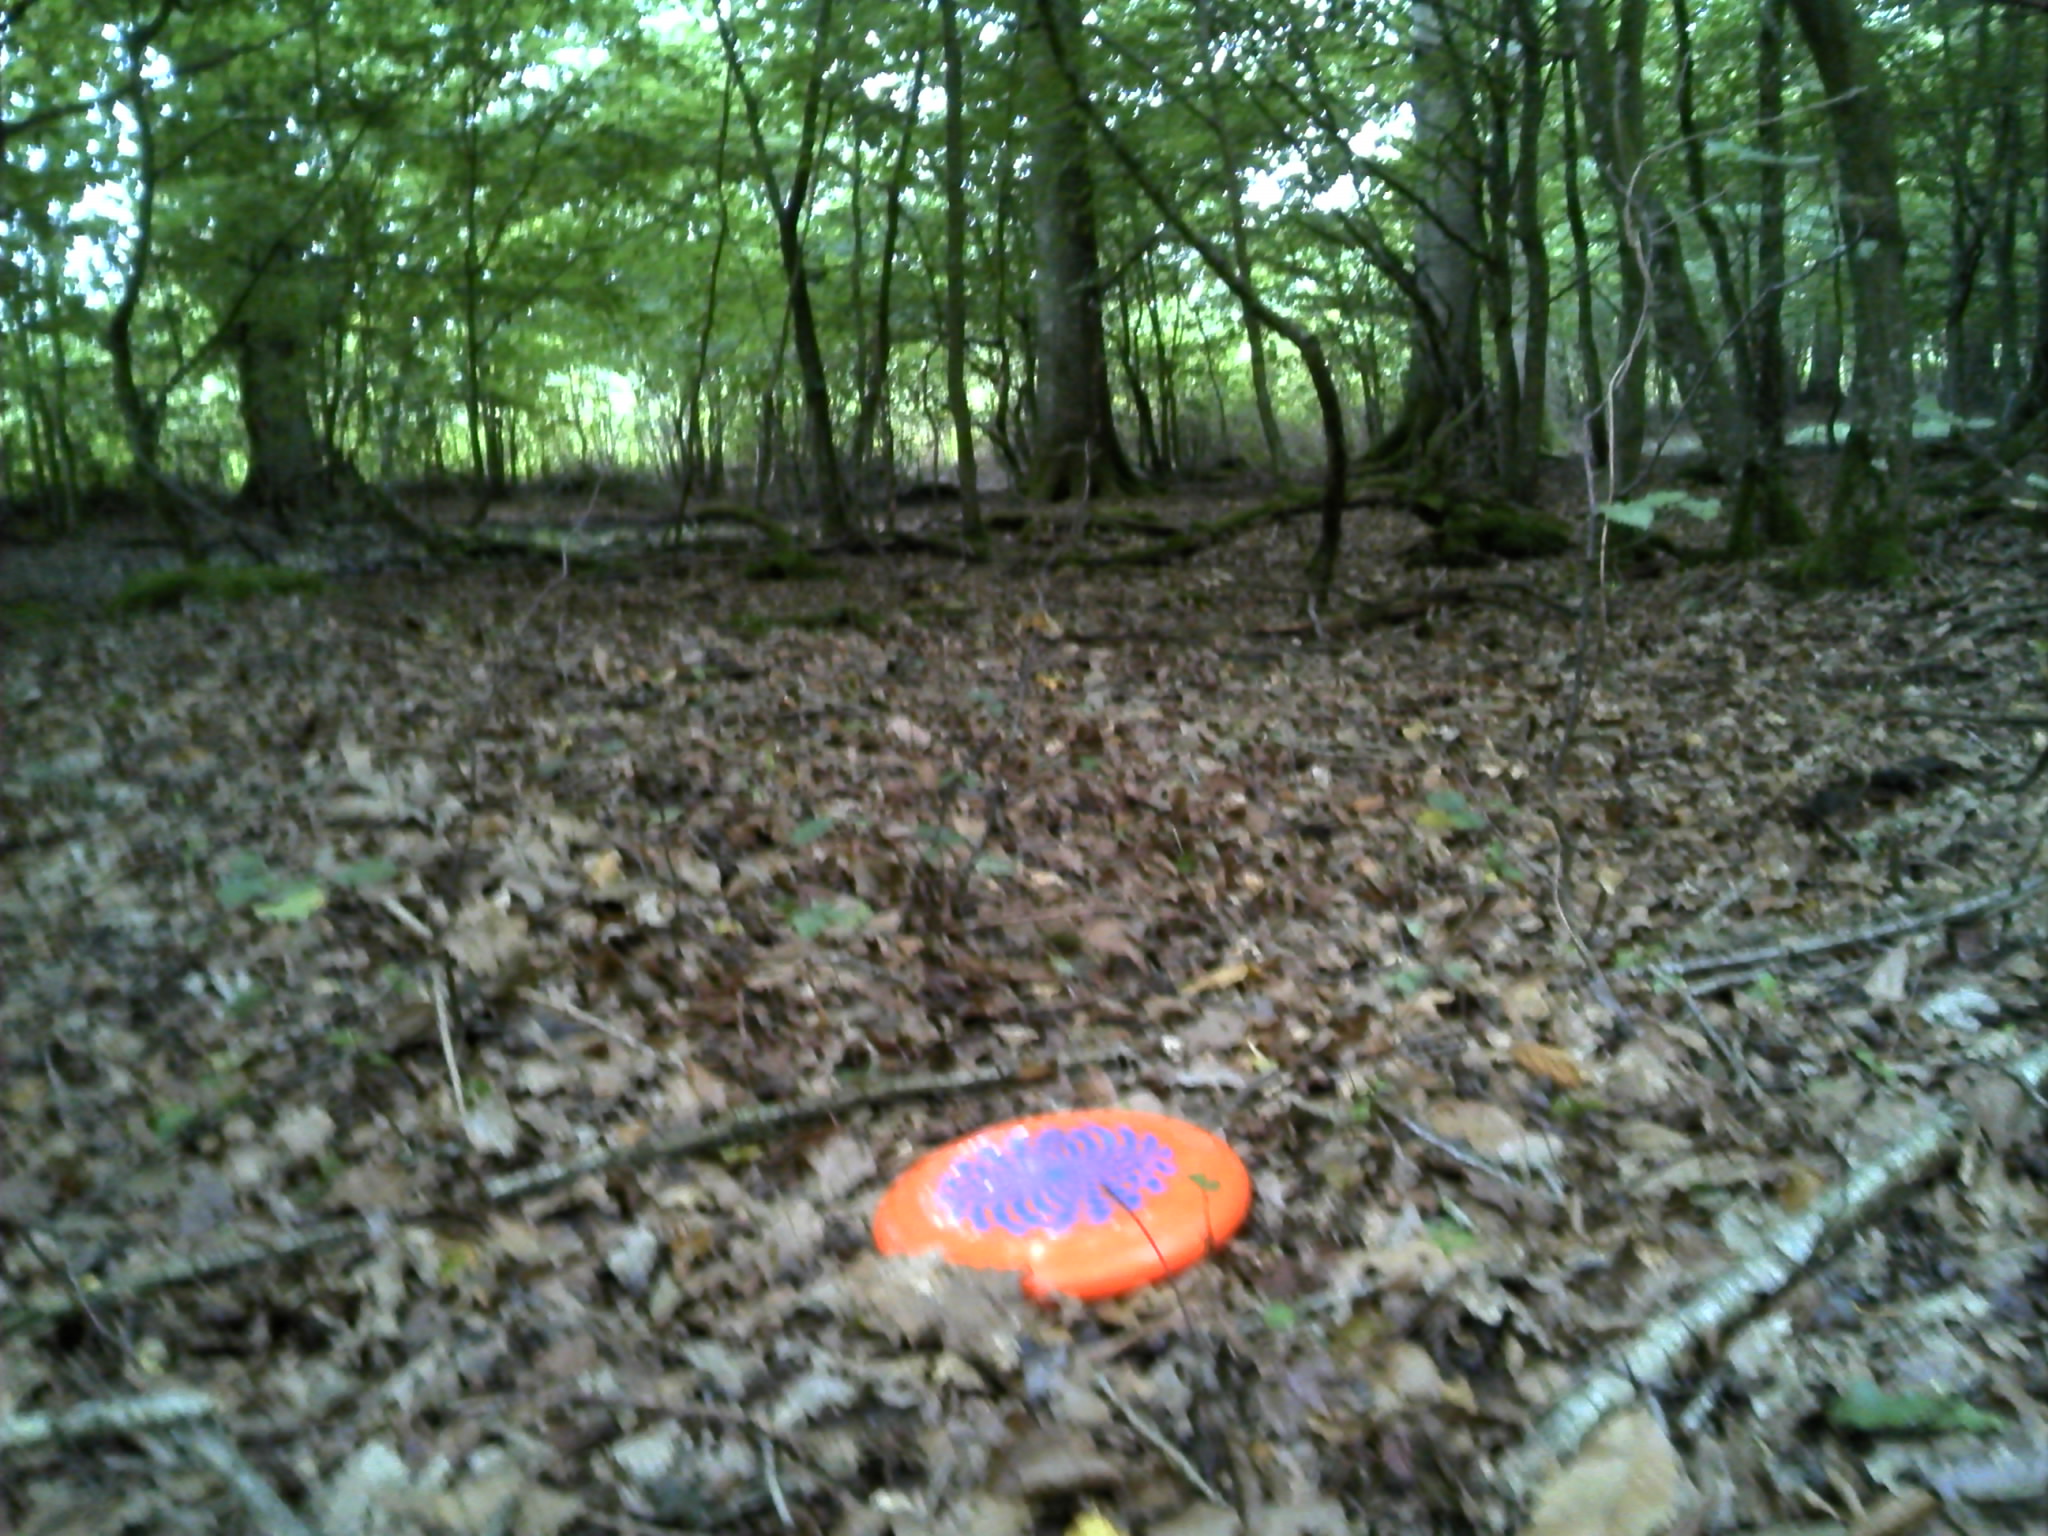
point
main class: Woodland
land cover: Broadleaved woodland
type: mesophytic deciduous forest
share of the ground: > 75 %
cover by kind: broadleaved forest trees 90 %, herbaceous plants 5 %, lichens and mosses 5 %
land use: Forestry
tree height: > 5 m
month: September
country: FR
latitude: 47.9696
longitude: 0.6419
